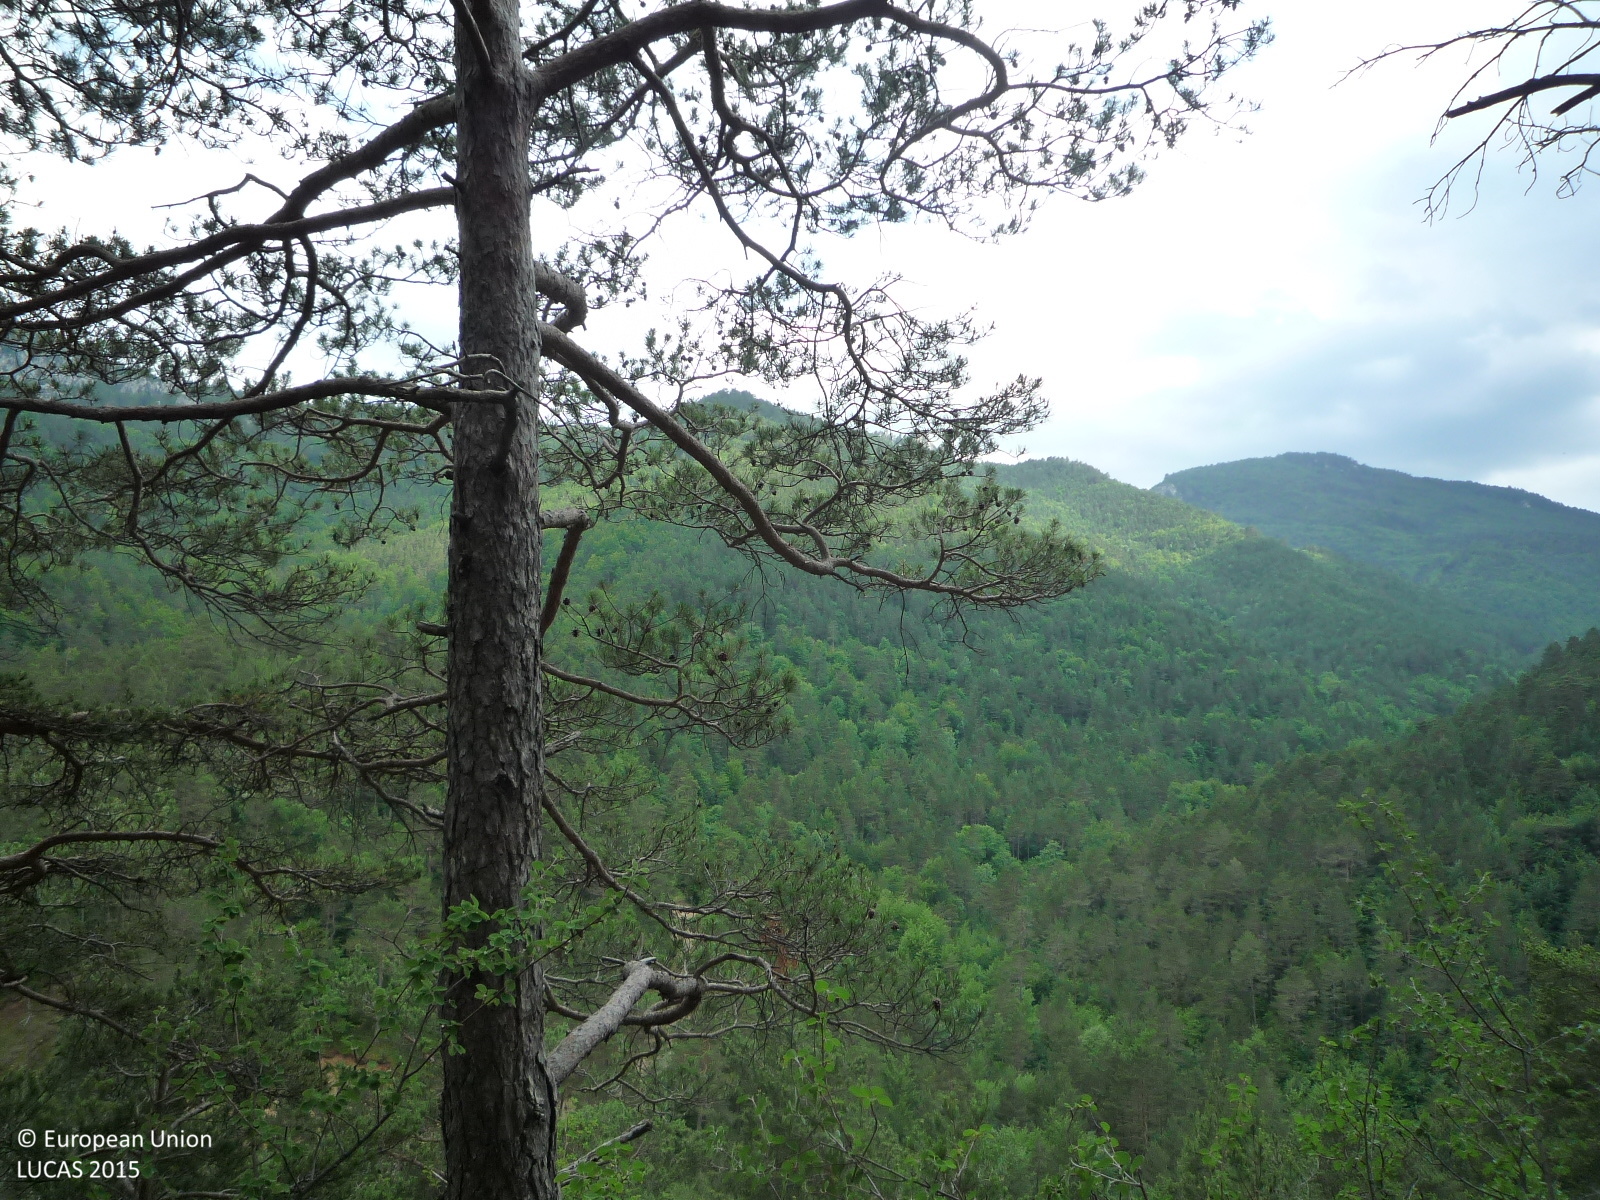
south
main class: Woodland
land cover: Pine dominated mixed woodland
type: alpine coniferous forest
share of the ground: > 75 %
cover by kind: coniferous forest trees 60 %, broadleaved forest trees 20 %, consolidated bare surface 20 %
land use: Forestry
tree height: > 5 m
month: June
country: ES
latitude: 42.2248
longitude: 1.9556
